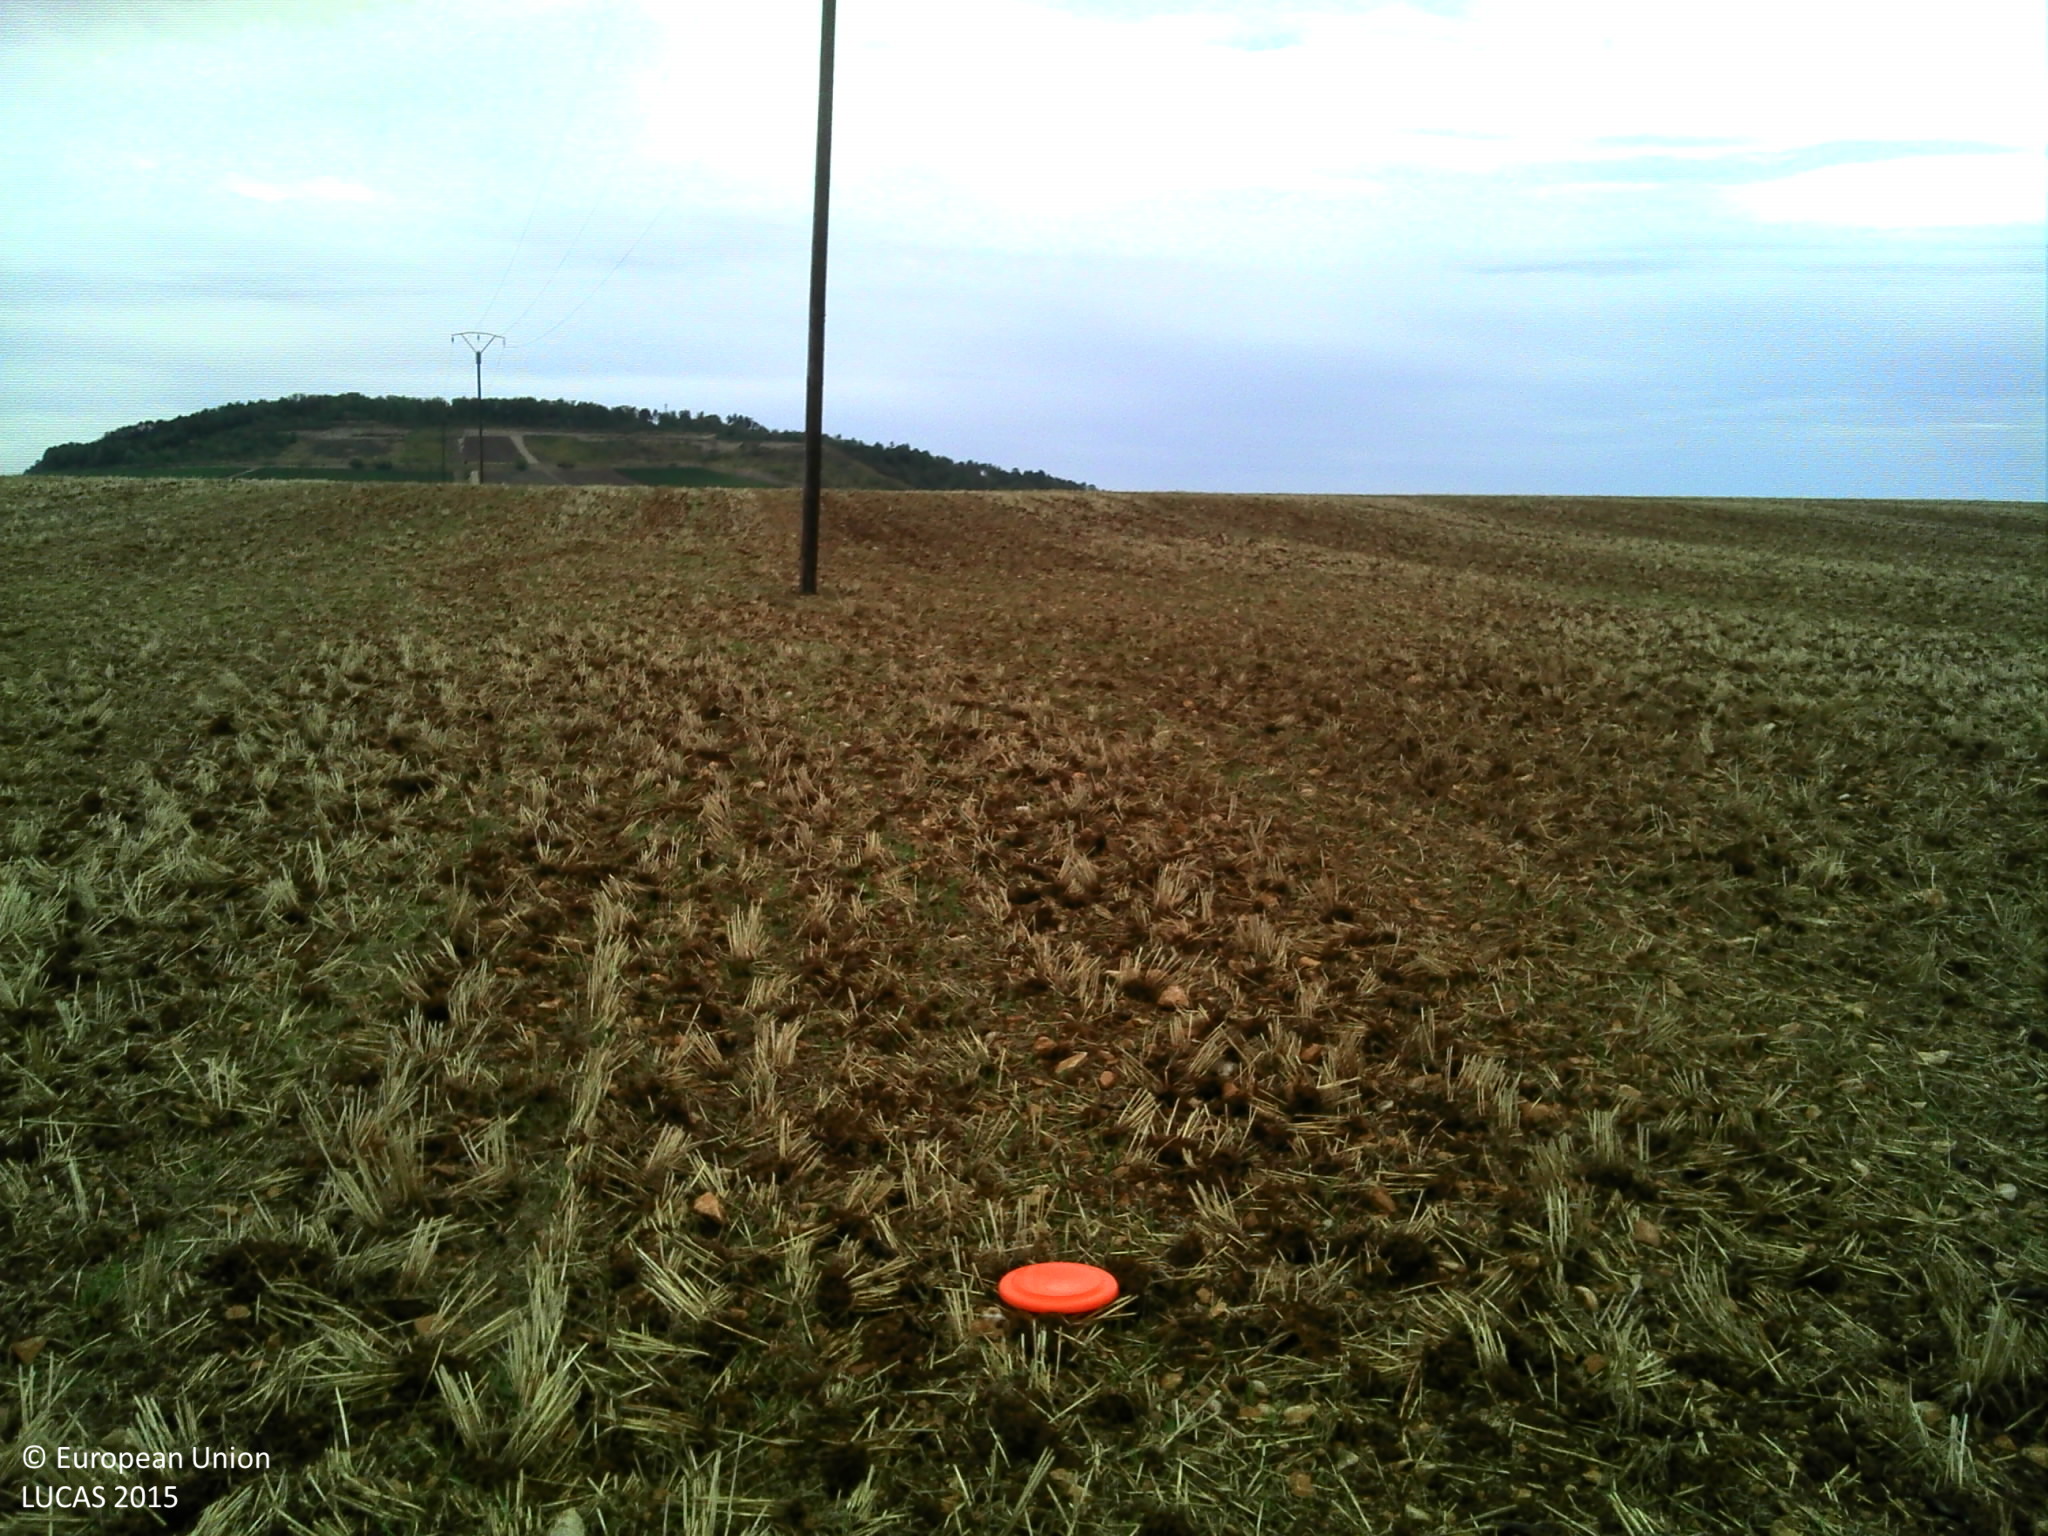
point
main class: Cropland
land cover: Common wheat
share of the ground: 10 - 25 %
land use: Agriculture (excluding fallow land and kitchen gardens)
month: August
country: FR
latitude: 47.8972
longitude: 4.6884
